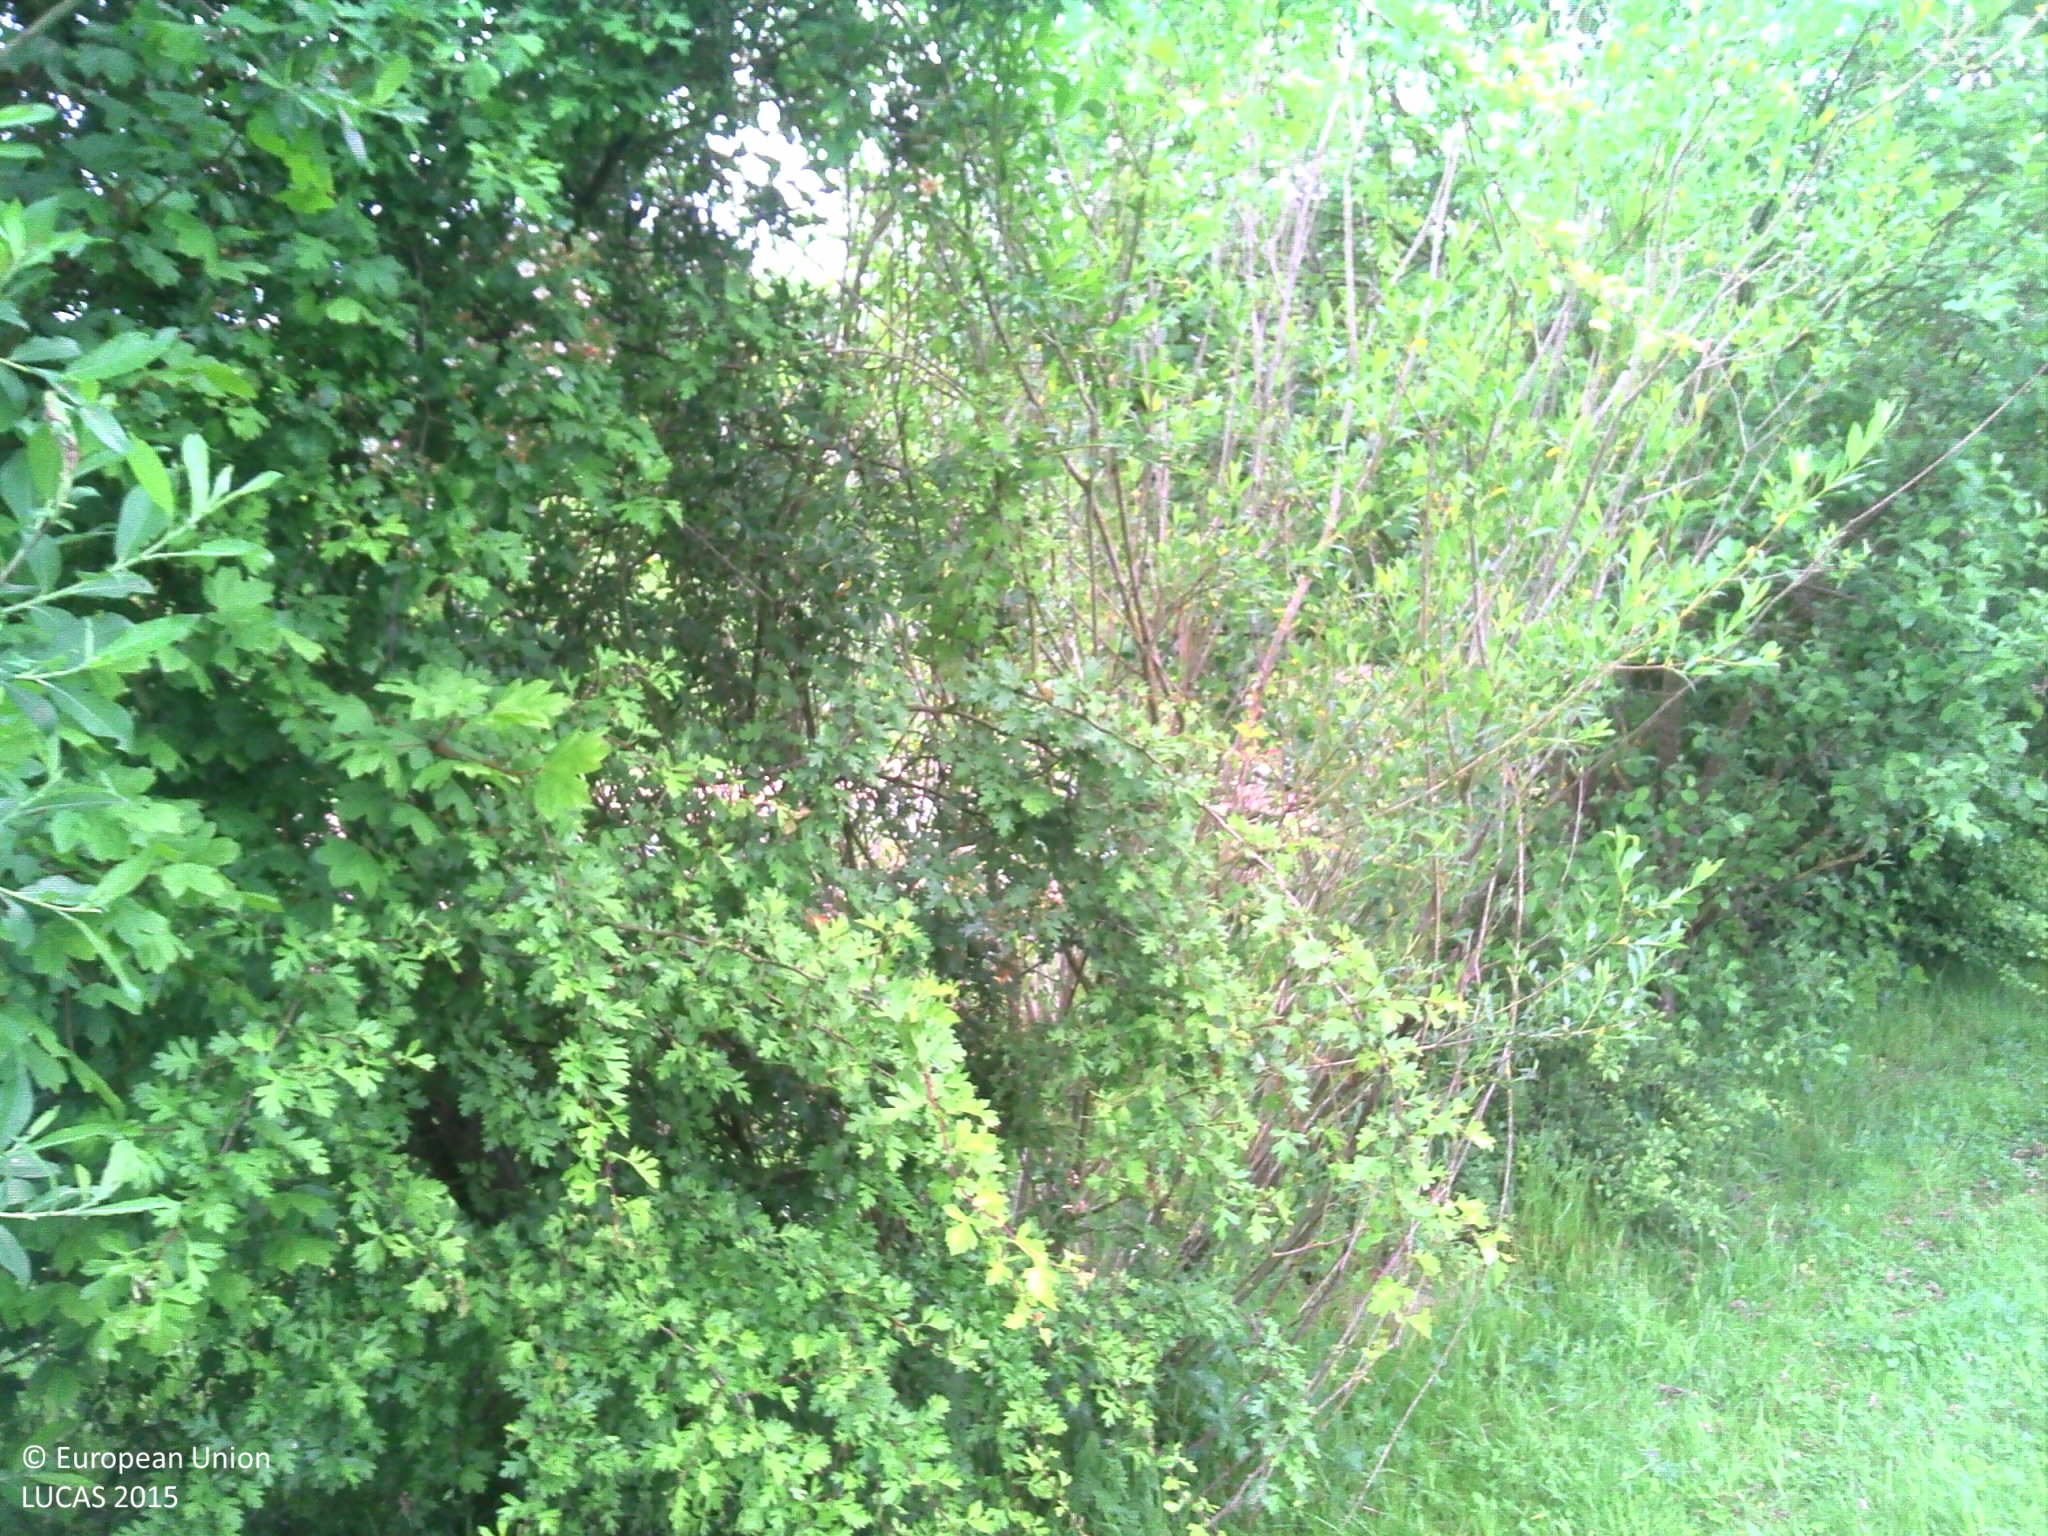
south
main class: Grassland
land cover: Grassland without tree/shrub cover
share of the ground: > 75 %
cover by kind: herbaceous plants 100 %
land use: Agriculture (excluding fallow land and kitchen gardens)
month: May
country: BE
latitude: 50.7011
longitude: 4.5164
